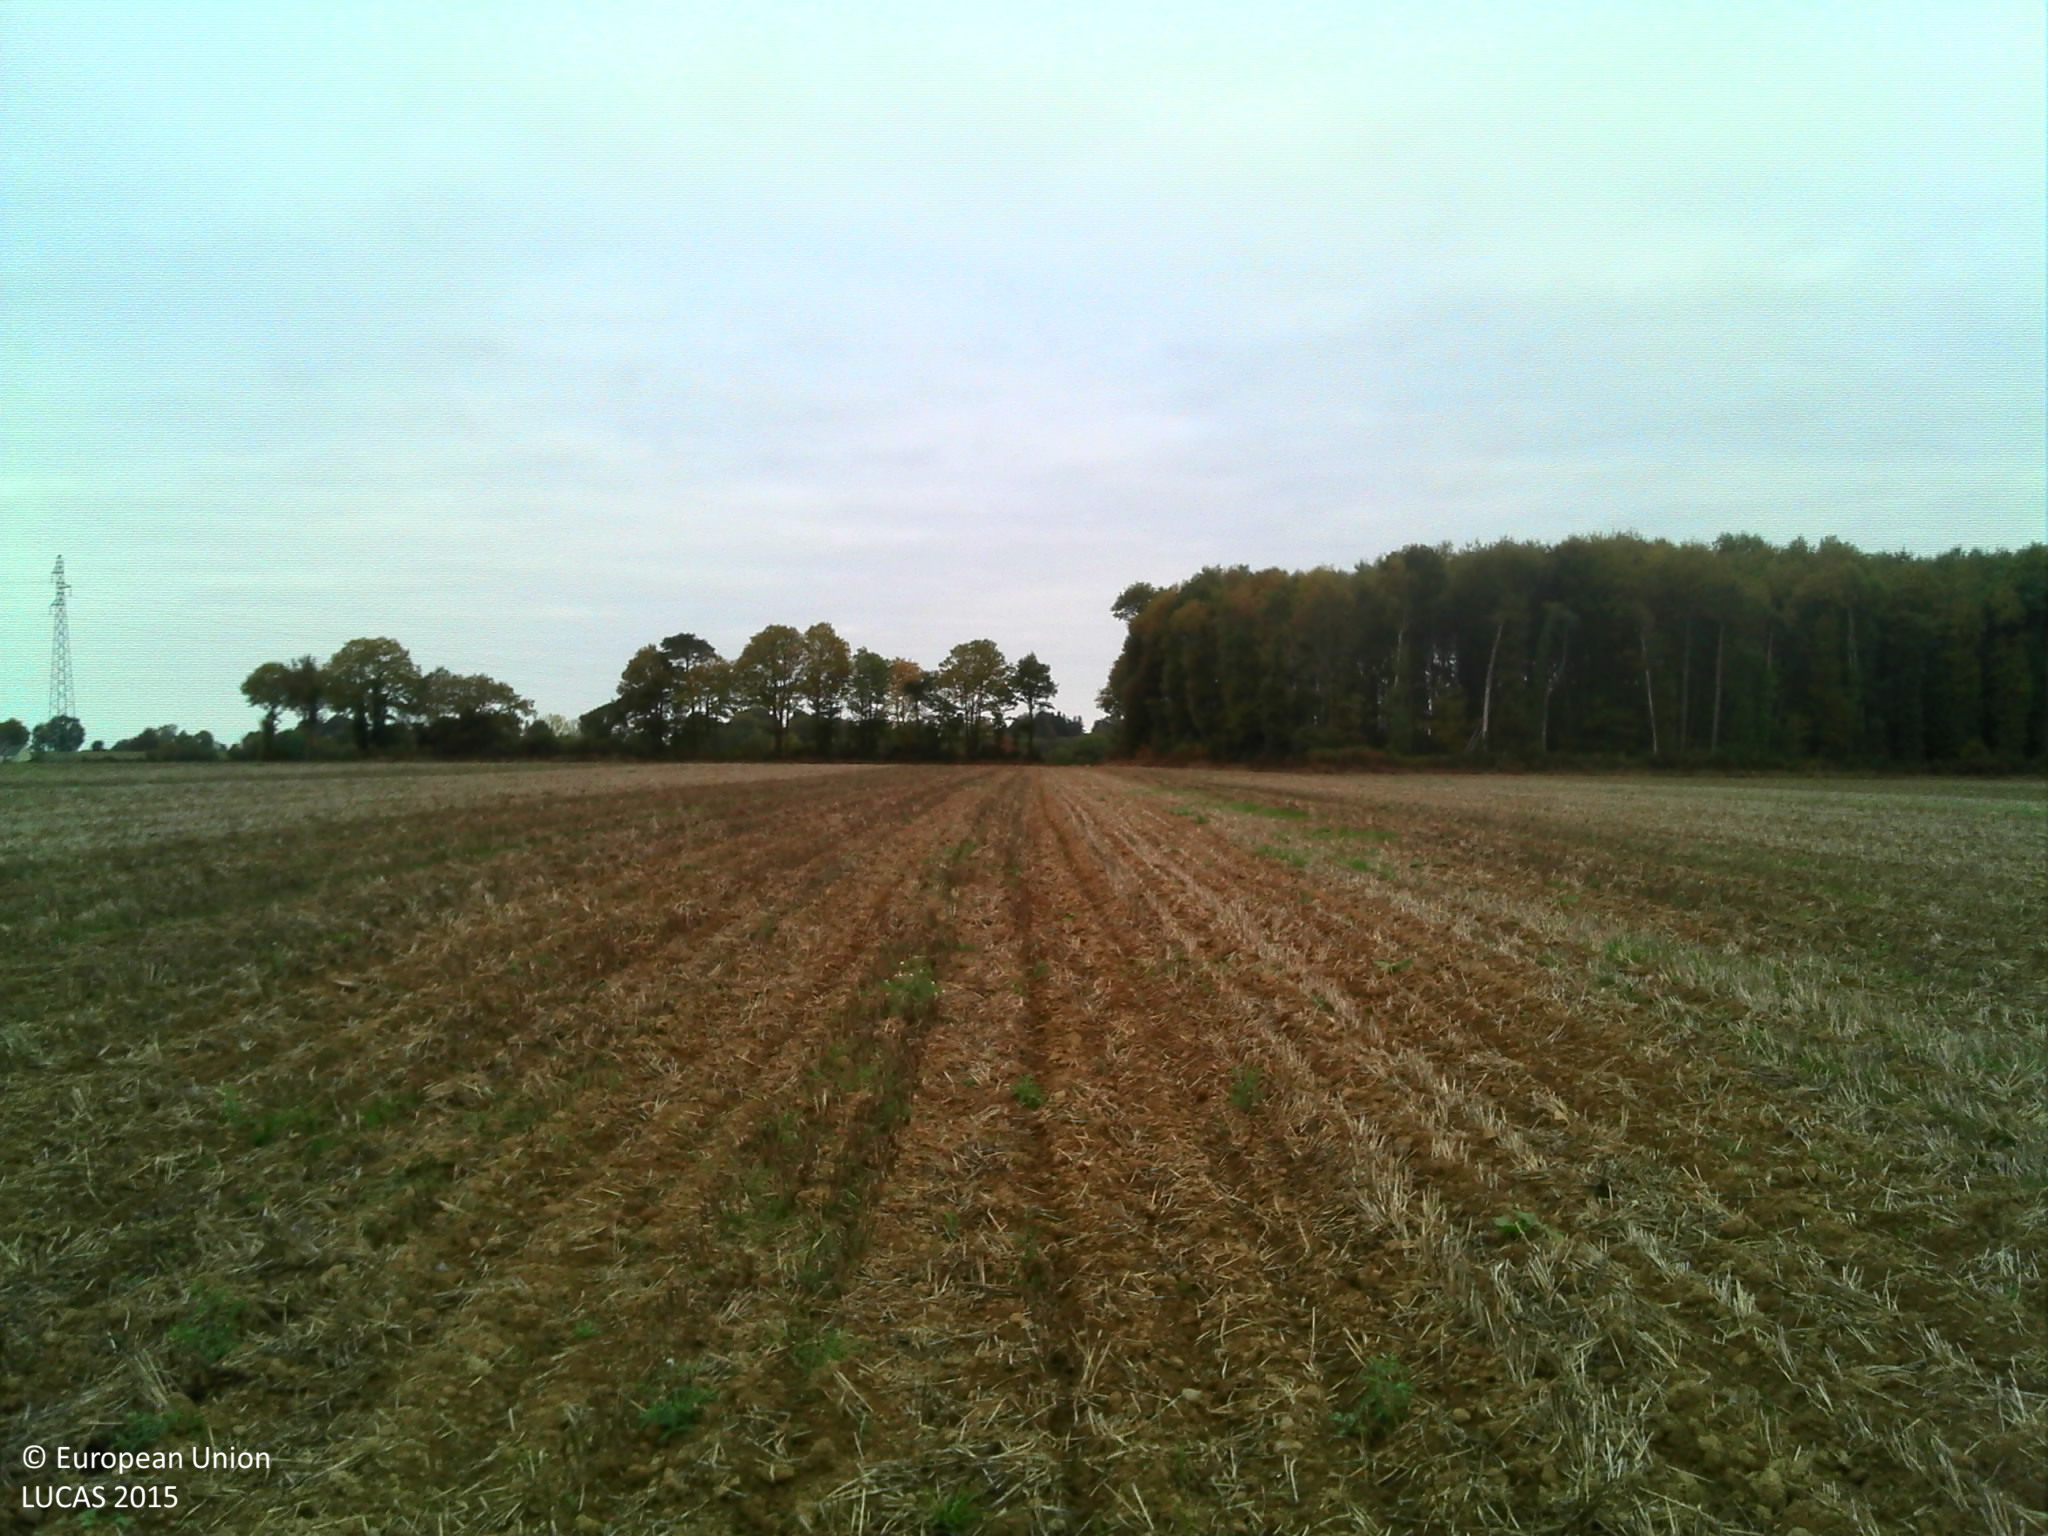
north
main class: Cropland
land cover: Common wheat
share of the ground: < 10 %
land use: Agriculture (excluding fallow land and kitchen gardens)
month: October
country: FR
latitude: 48.1382
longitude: -2.4087
